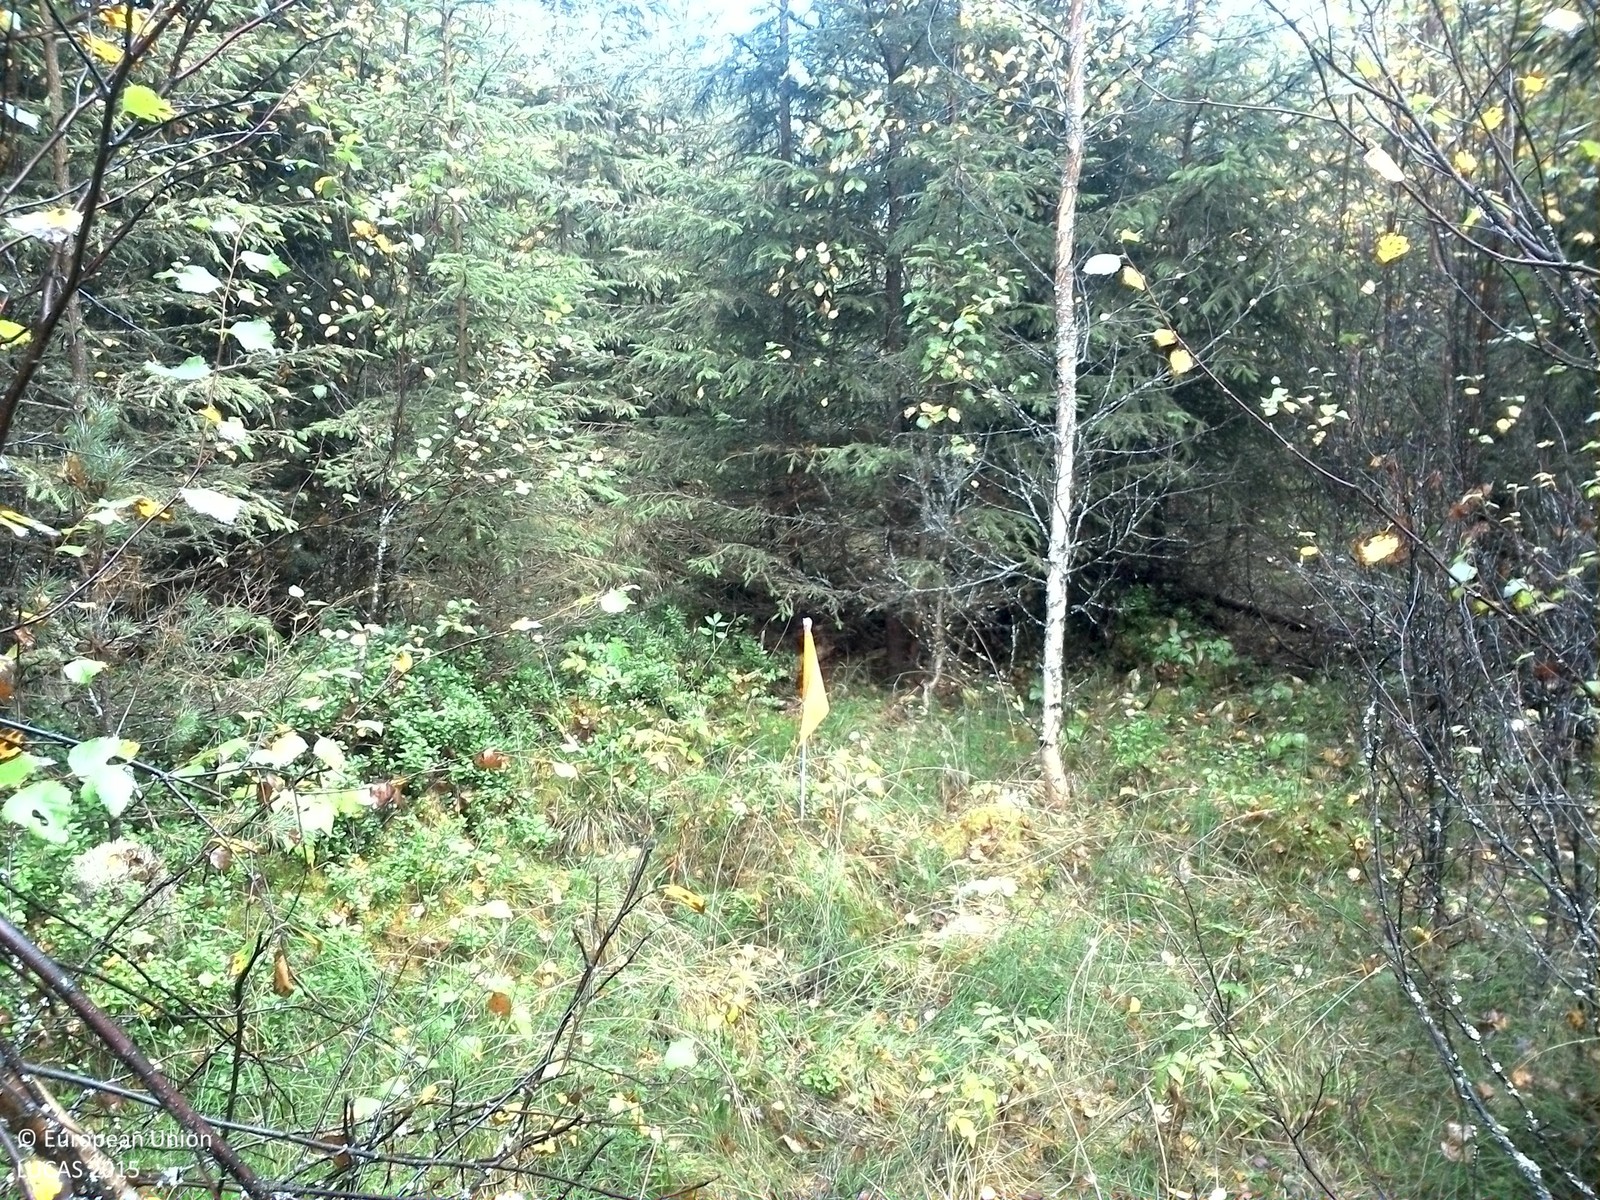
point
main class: Woodland
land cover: Spruce dominated mixed woodland
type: boreal forest
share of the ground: 50 - 75 %
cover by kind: coniferous forest trees 45 %, broadleaved forest trees 25 %, shrubs 15 %, herbaceous plants 15 %
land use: Forestry
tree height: < 5 m
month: September
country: SE
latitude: 61.1753
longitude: 14.9871
